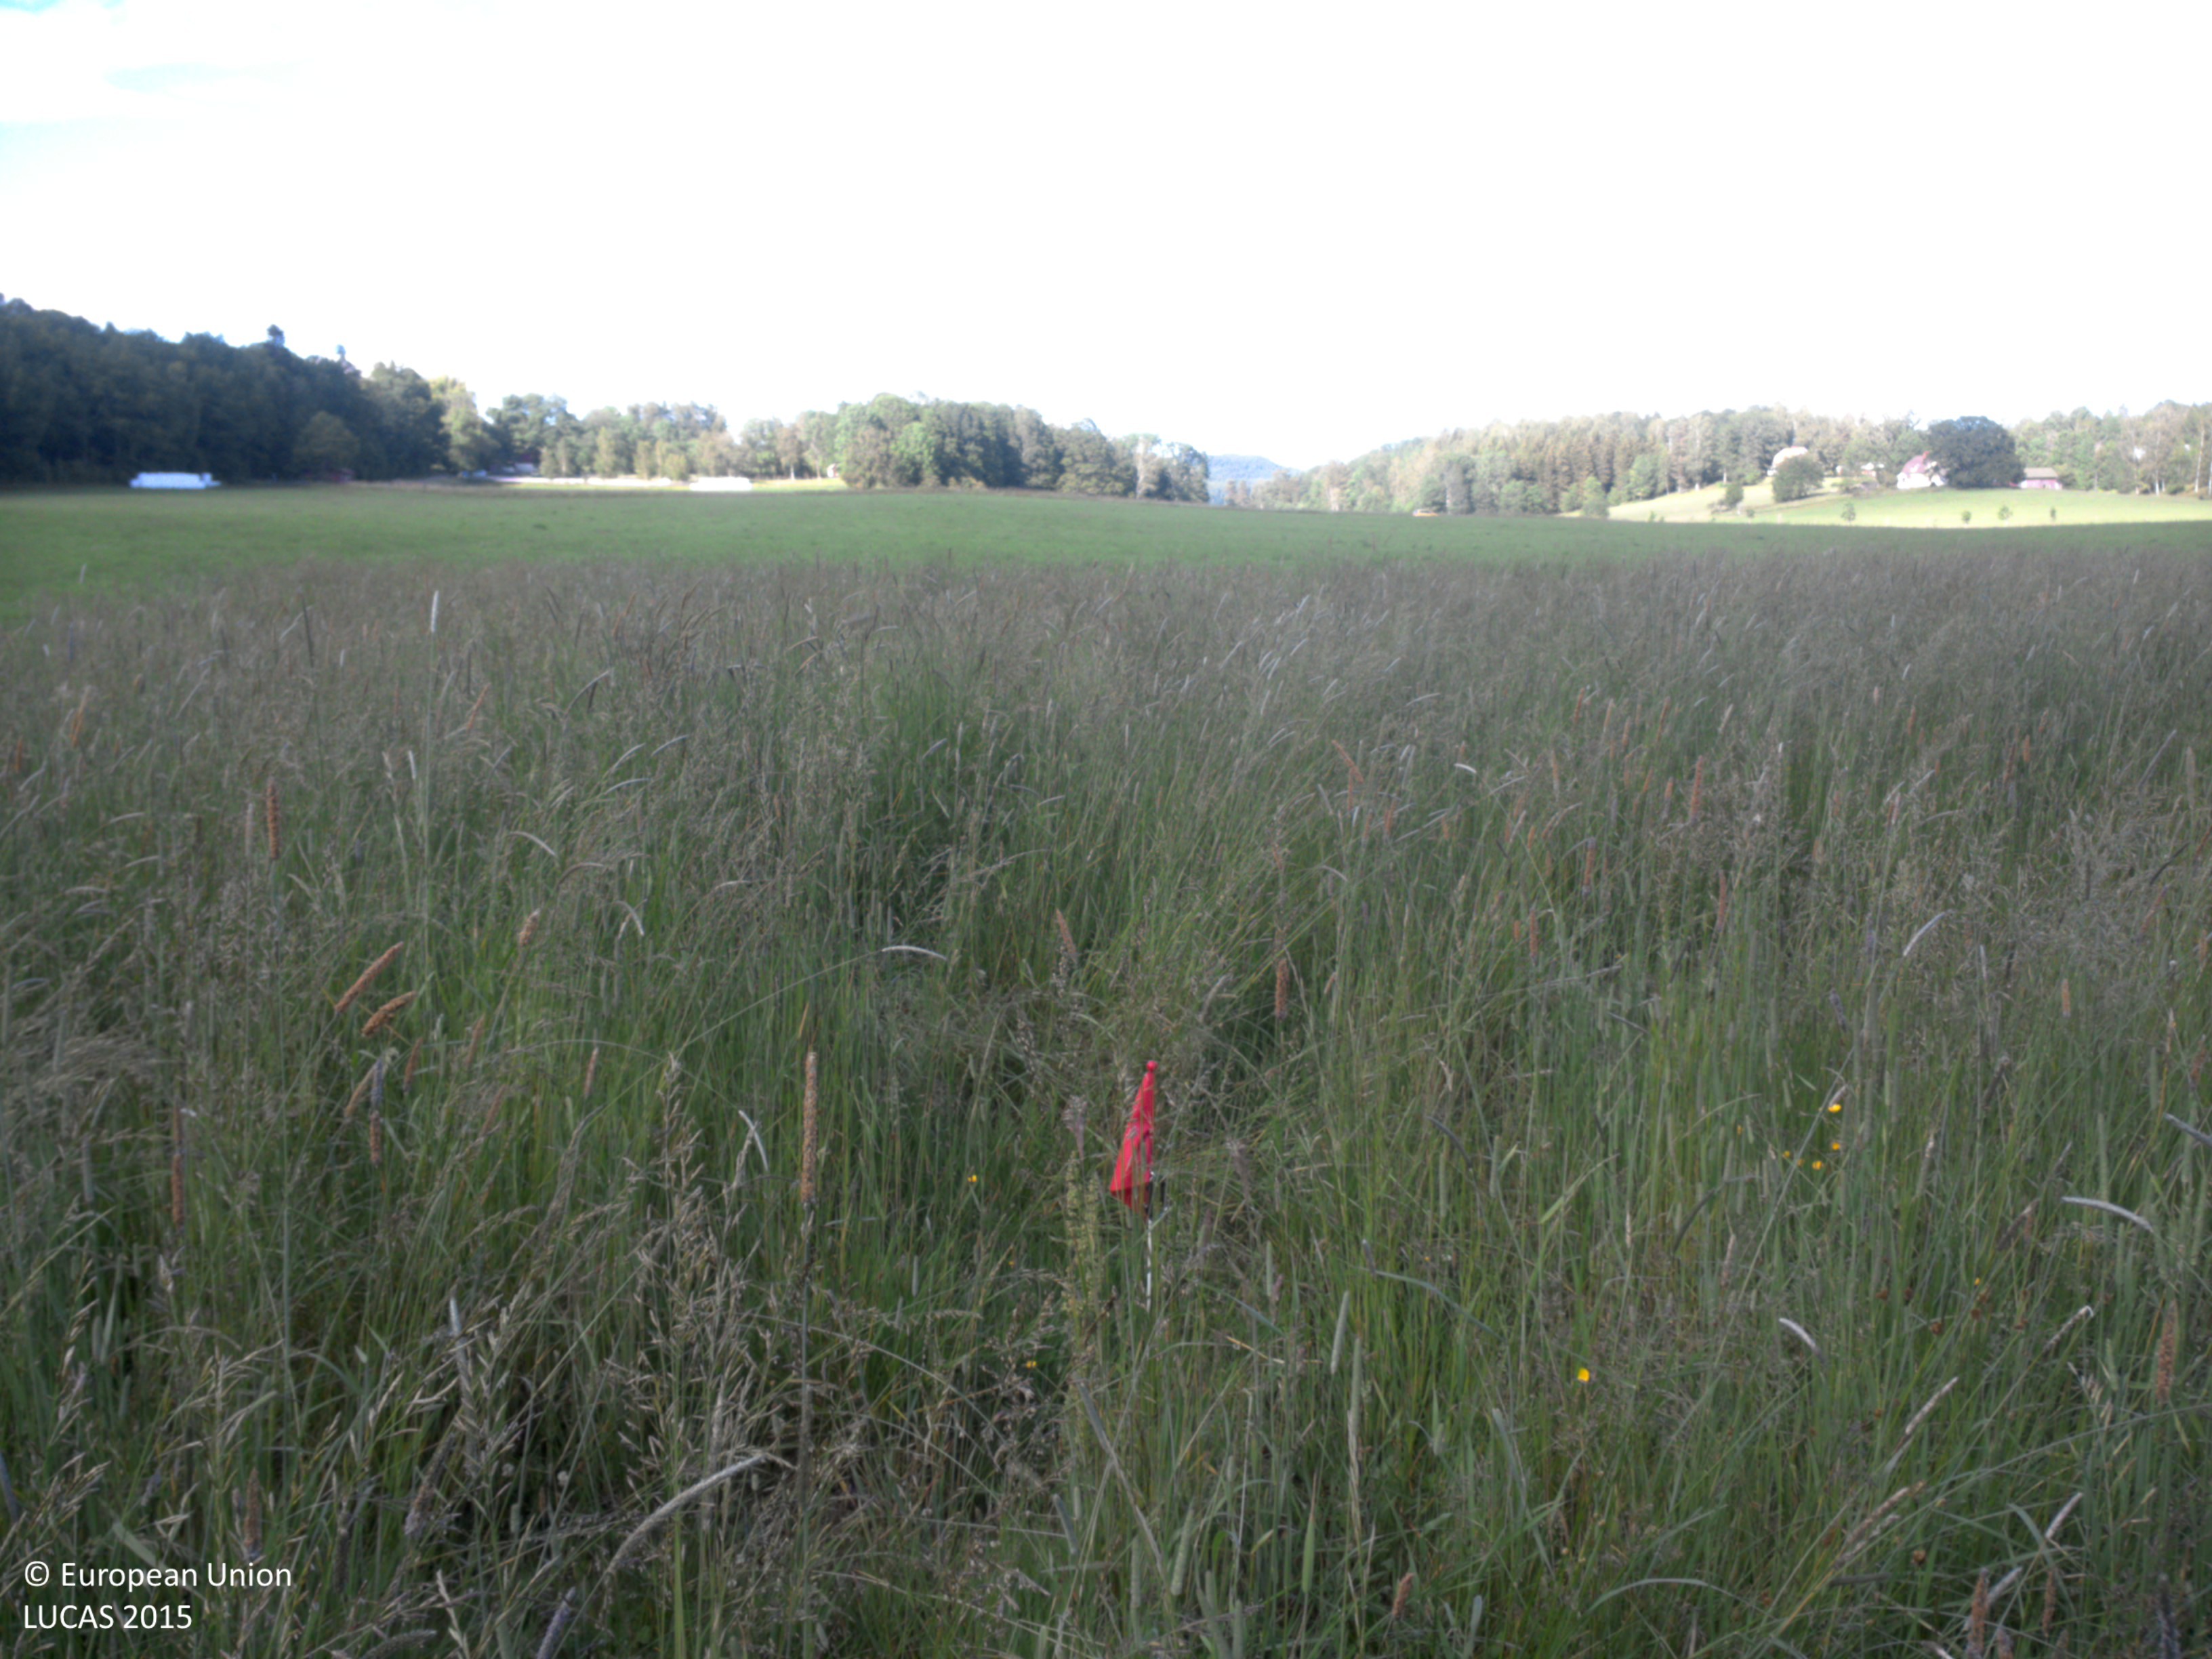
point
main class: Cropland
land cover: Mixed cereals for fodder
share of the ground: > 75 %
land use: Agriculture (excluding fallow land and kitchen gardens)
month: June
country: SE
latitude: 58.9561
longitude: 12.2723
